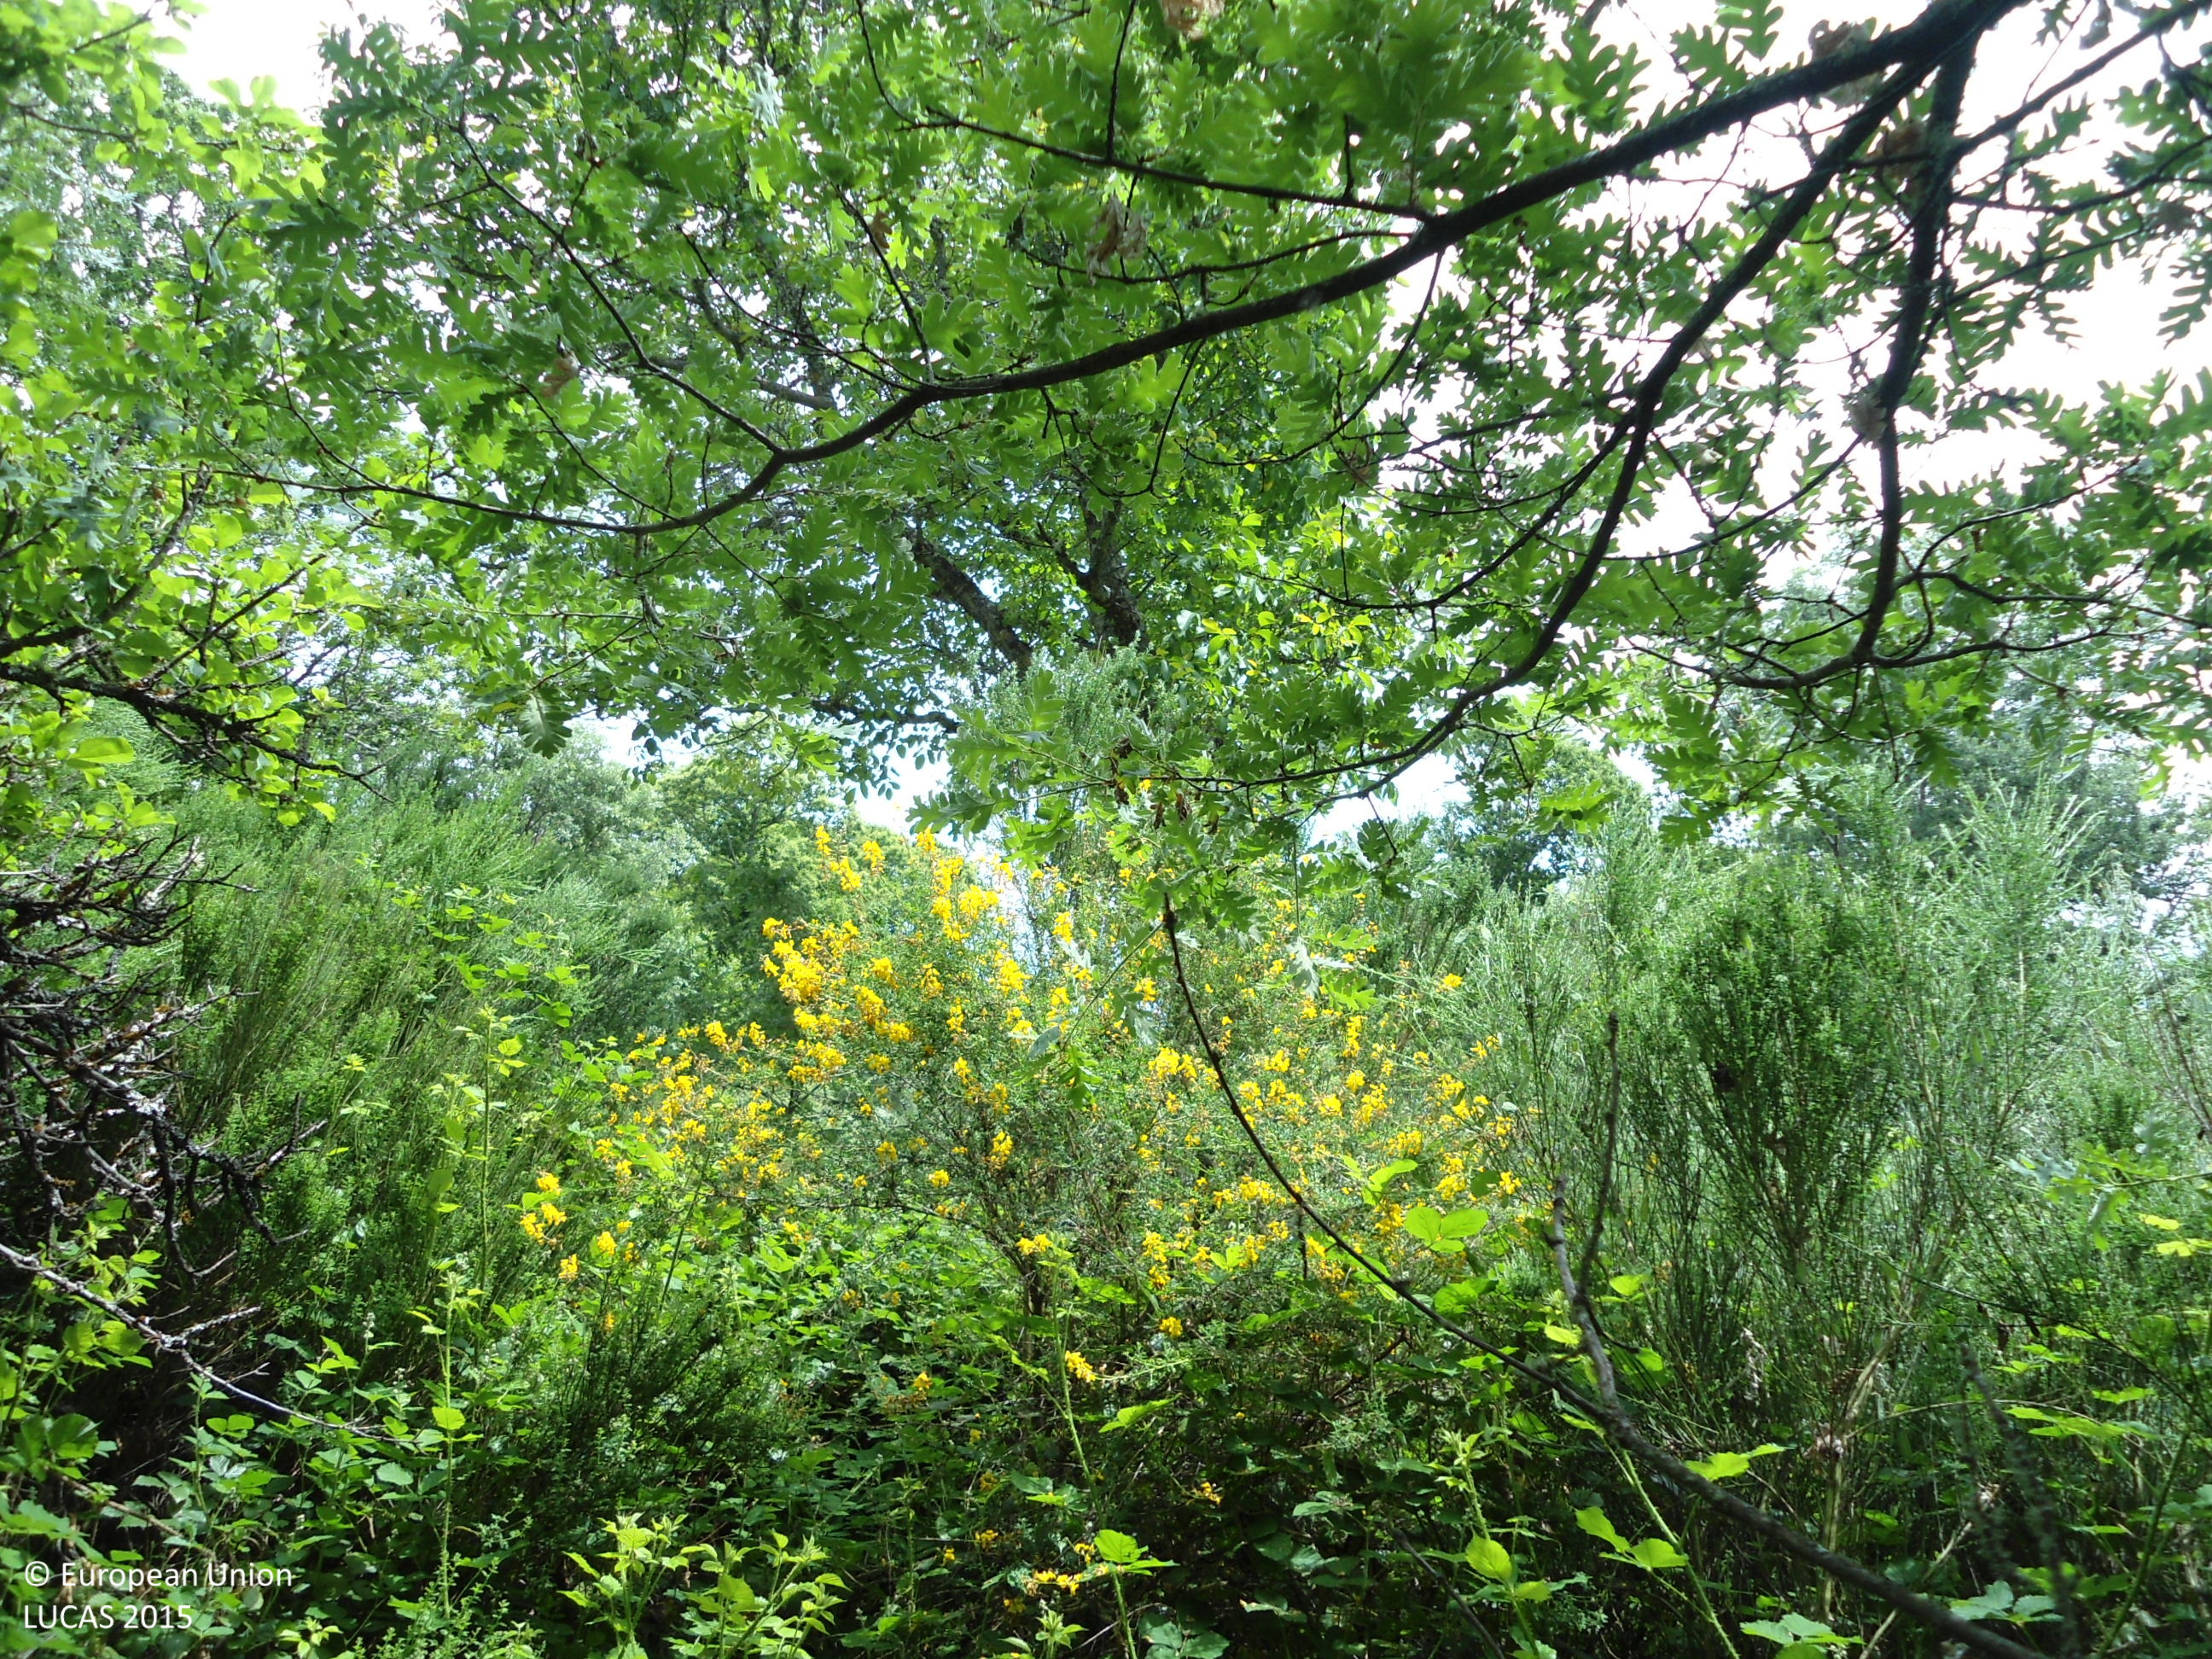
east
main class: Woodland
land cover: Broadleaved woodland
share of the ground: > 75 %
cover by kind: broadleaved forest trees 90 %, shrubs 10 %
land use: Forestry
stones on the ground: < 10 %
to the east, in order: Broadleaved woodland; Dry stone walls; Grass margins; Paved roads, cycling and walking lanes; Grass margins; Dry stone walls; Shrubland with sparse tree cover; Broadleaved woodland; Dry stone walls; Tracks; Broadleaved woodland; Shrubland without tree cover; Electric lines; Shrubland without tree cover; Shrubland with sparse tree cover; Groves; Paved roads, cycling and walking lanes; Grass margins
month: June
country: ES
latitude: 42.0978
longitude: -6.6187
